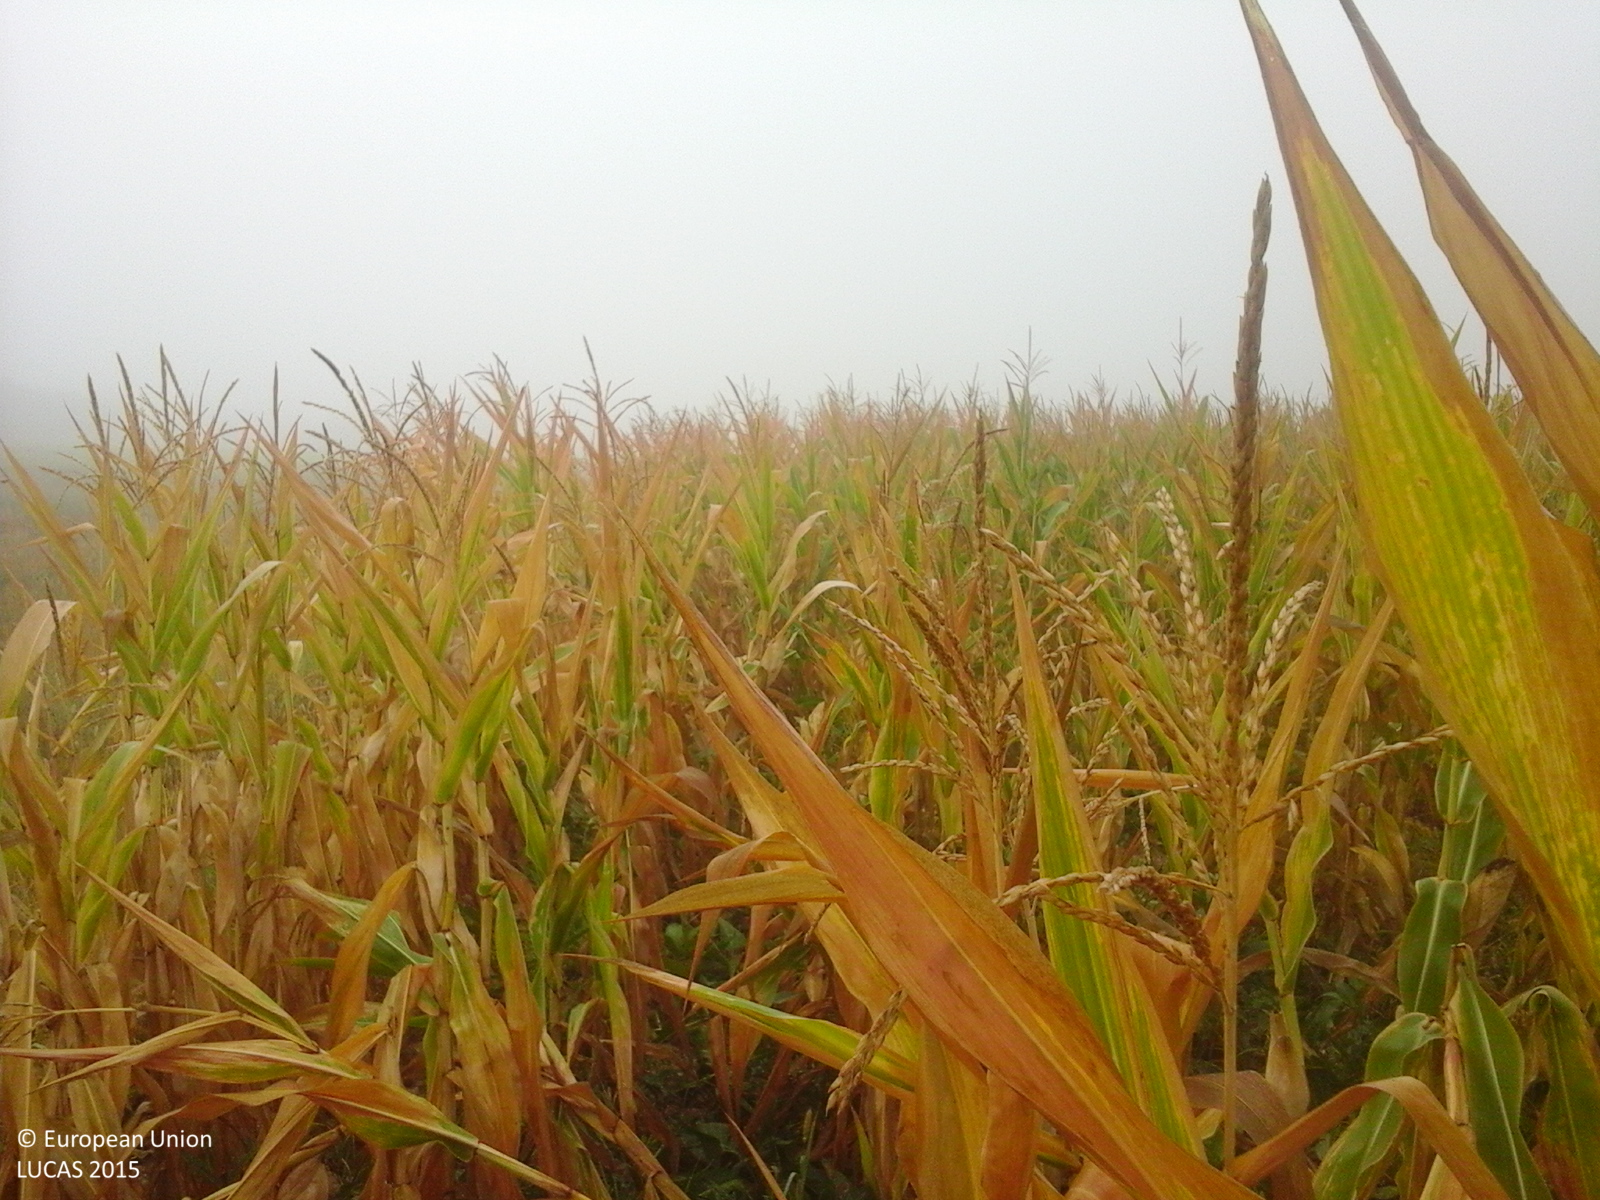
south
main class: Cropland
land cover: Maize
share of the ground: > 75 %
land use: Agriculture (excluding fallow land and kitchen gardens)
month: September
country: RO
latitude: 47.9996
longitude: 22.9739
